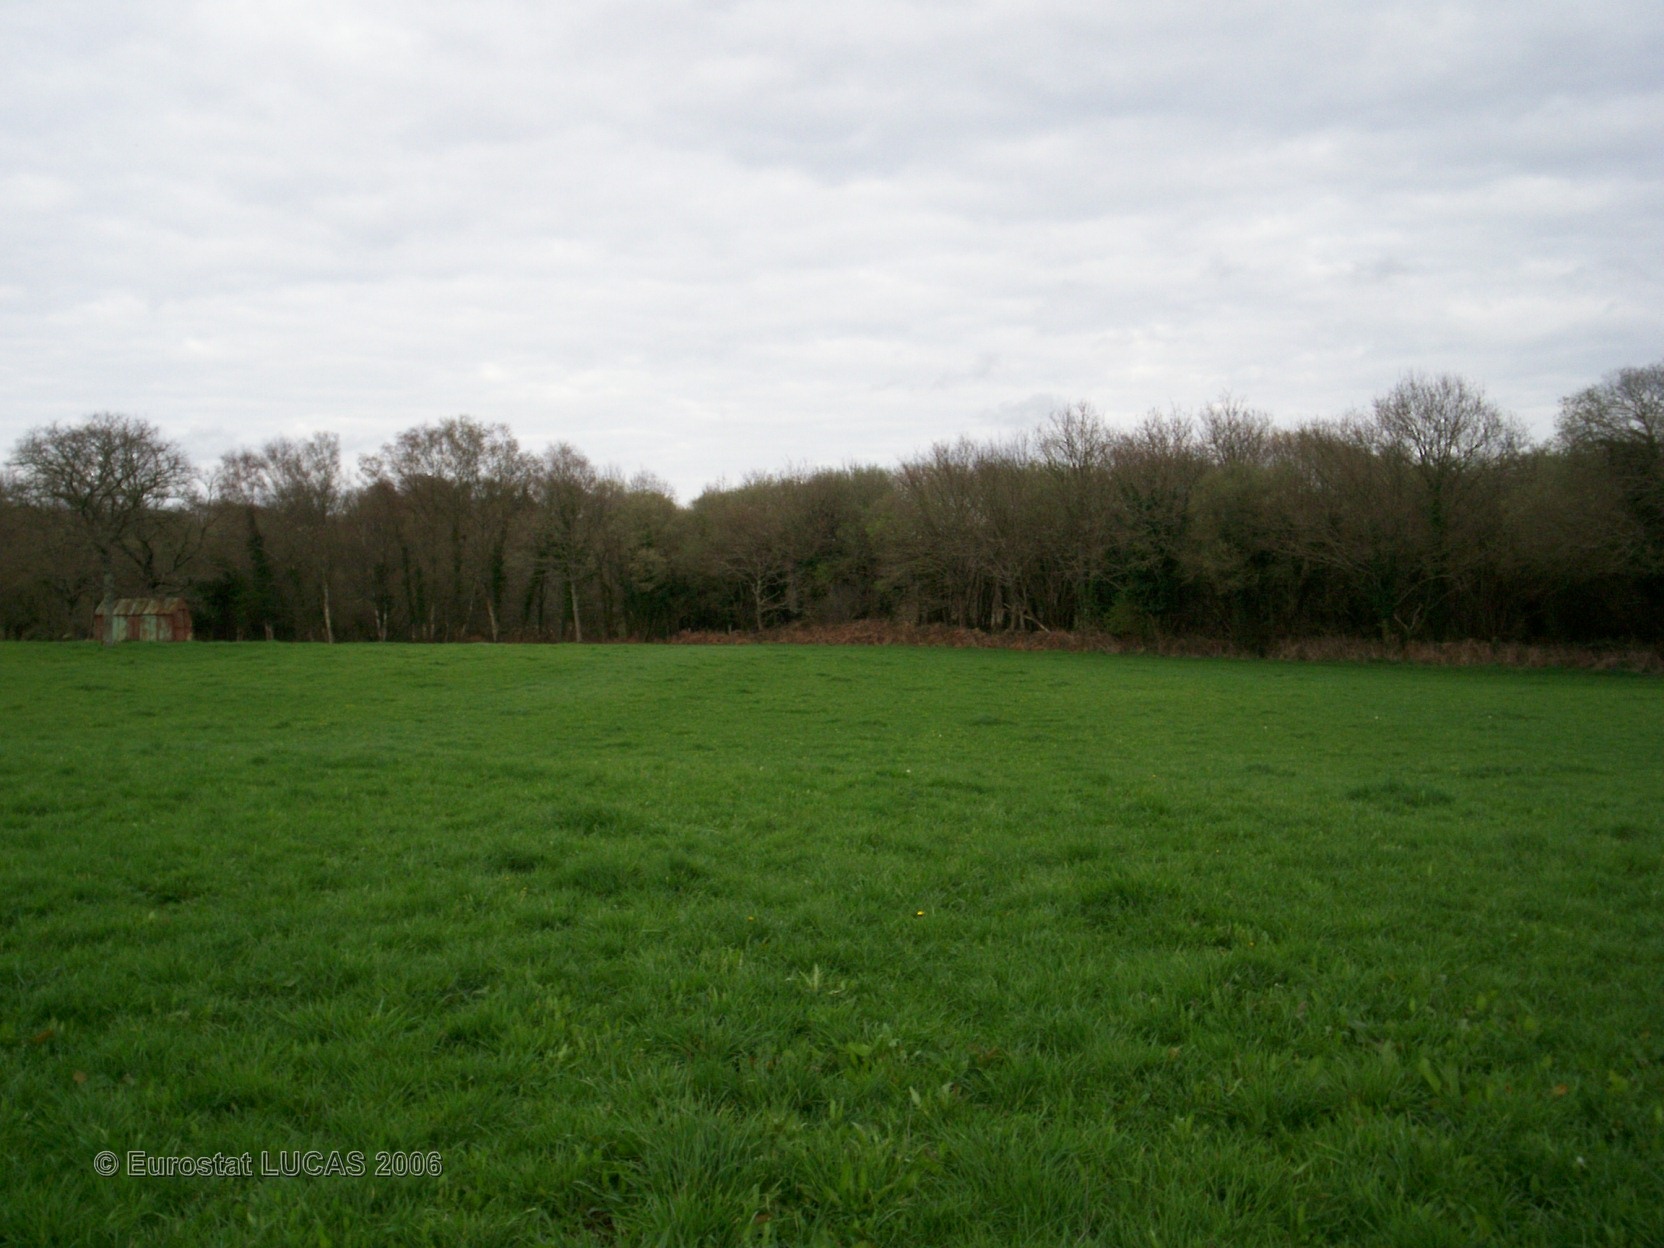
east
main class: Grassland
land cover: Grassland without tree/shrub cover
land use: Agriculture (excluding fallow land and kitchen gardens)
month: April
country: FR
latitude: 47.8085
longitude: -3.4957
